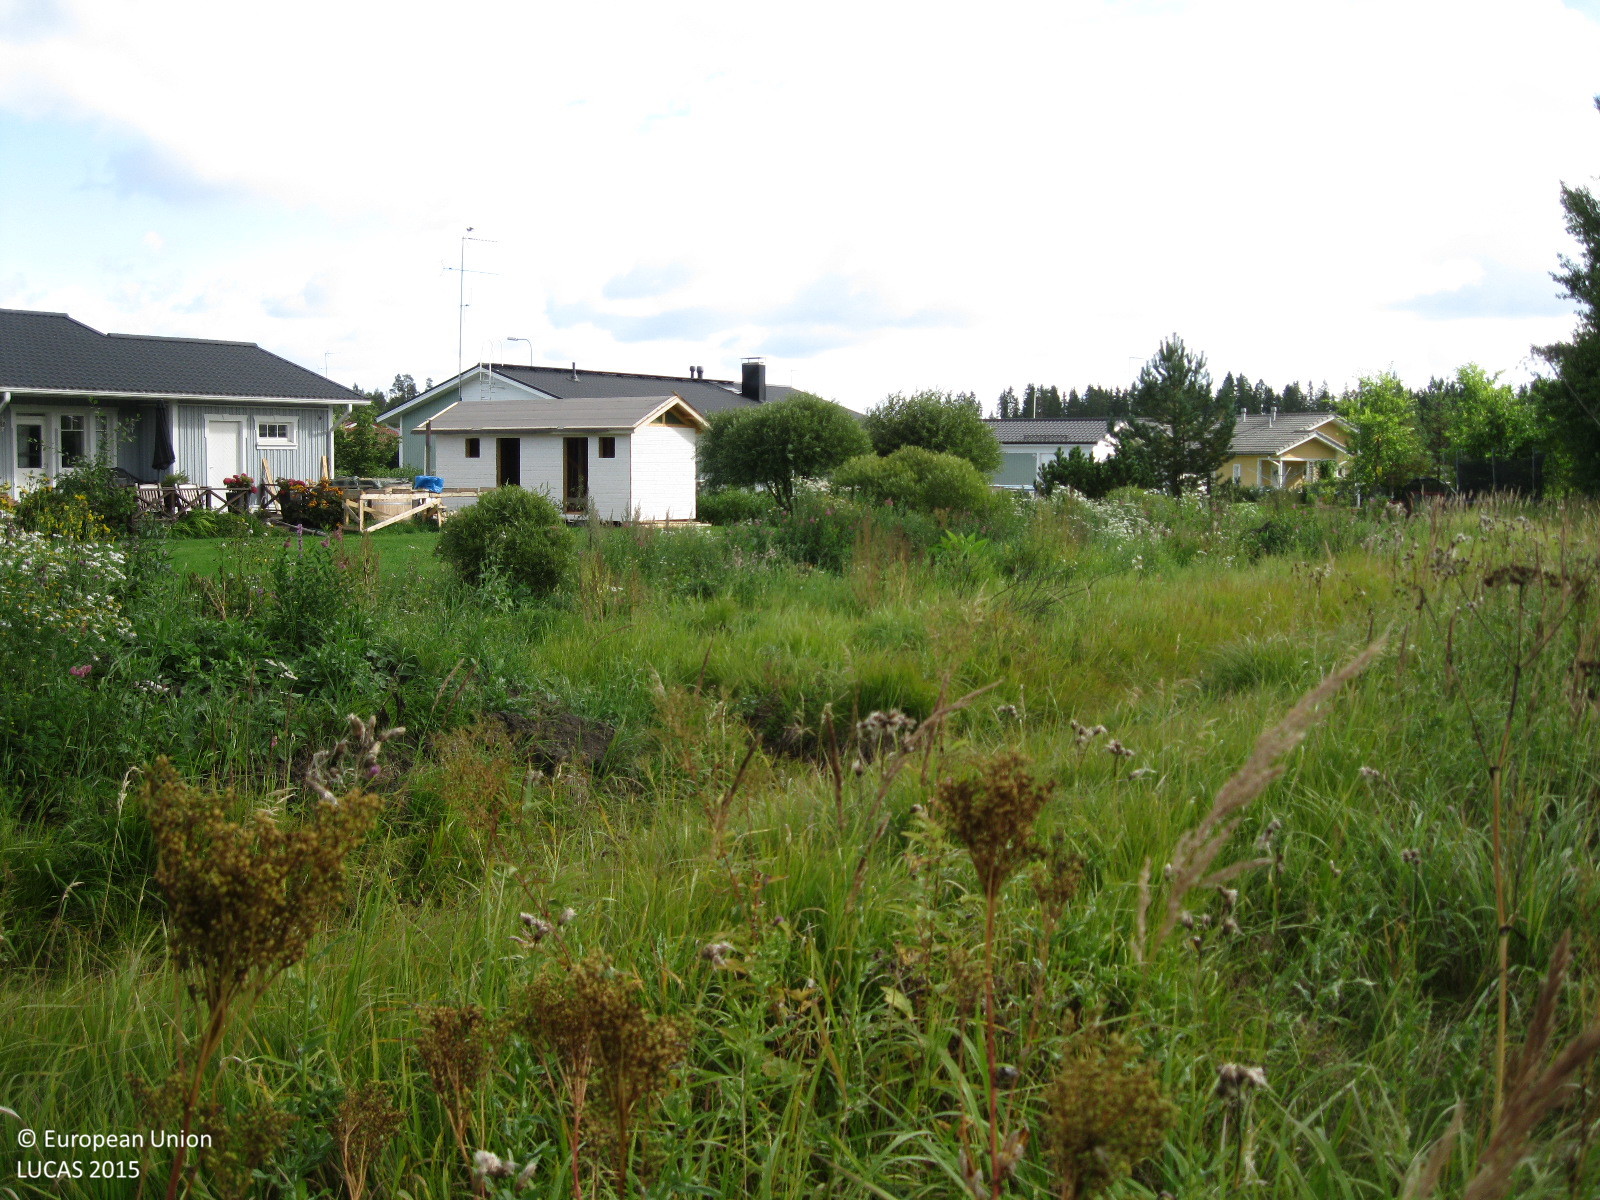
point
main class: Grassland
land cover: Grassland with sparse tree/shrub cover
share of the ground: > 75 %
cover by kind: herbaceous plants 95 %, broadleaved forest trees 5 %
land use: Residential
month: September
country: FI
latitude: 60.4741
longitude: 24.8303
